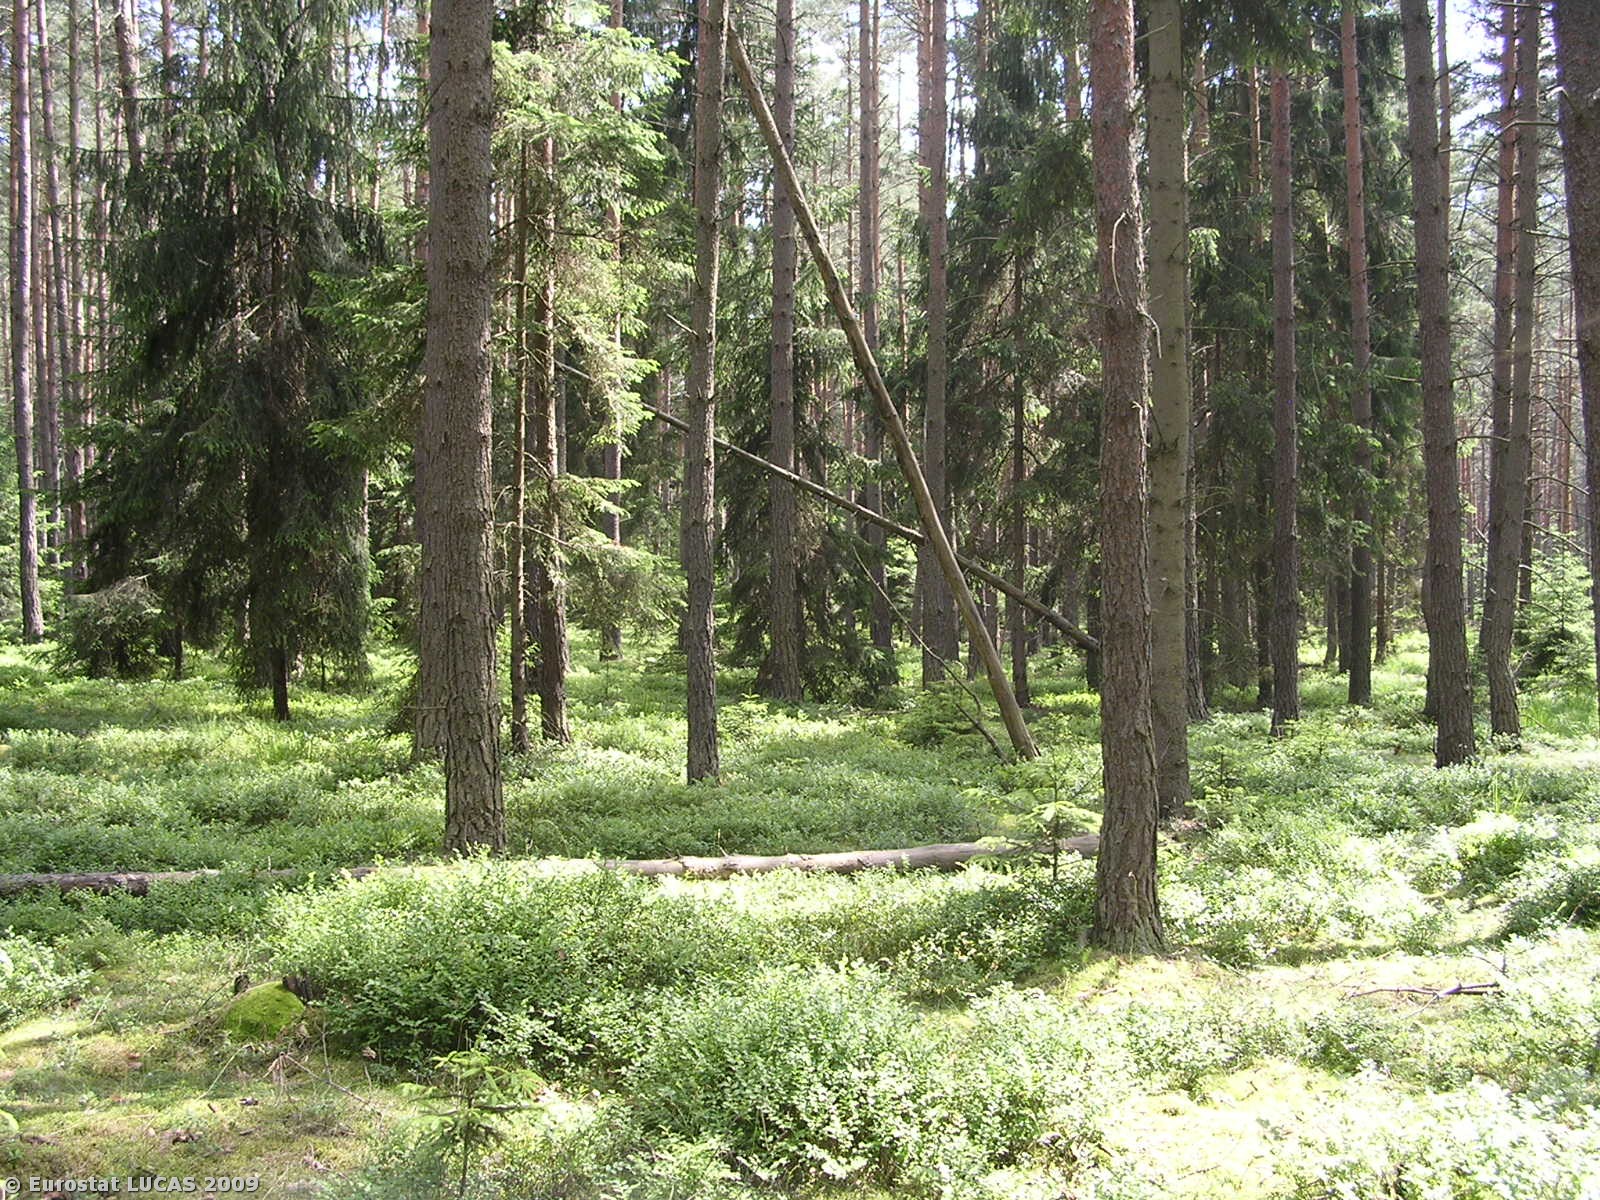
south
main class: Woodland
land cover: Coniferous woodland
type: hemiboreal forest and nemoral coniferous forest and mixed broadleaved-coniferous forest
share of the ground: > 75 %
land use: Forestry
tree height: > 5 m
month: June
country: CZ
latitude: 50.5903
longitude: 14.7343
